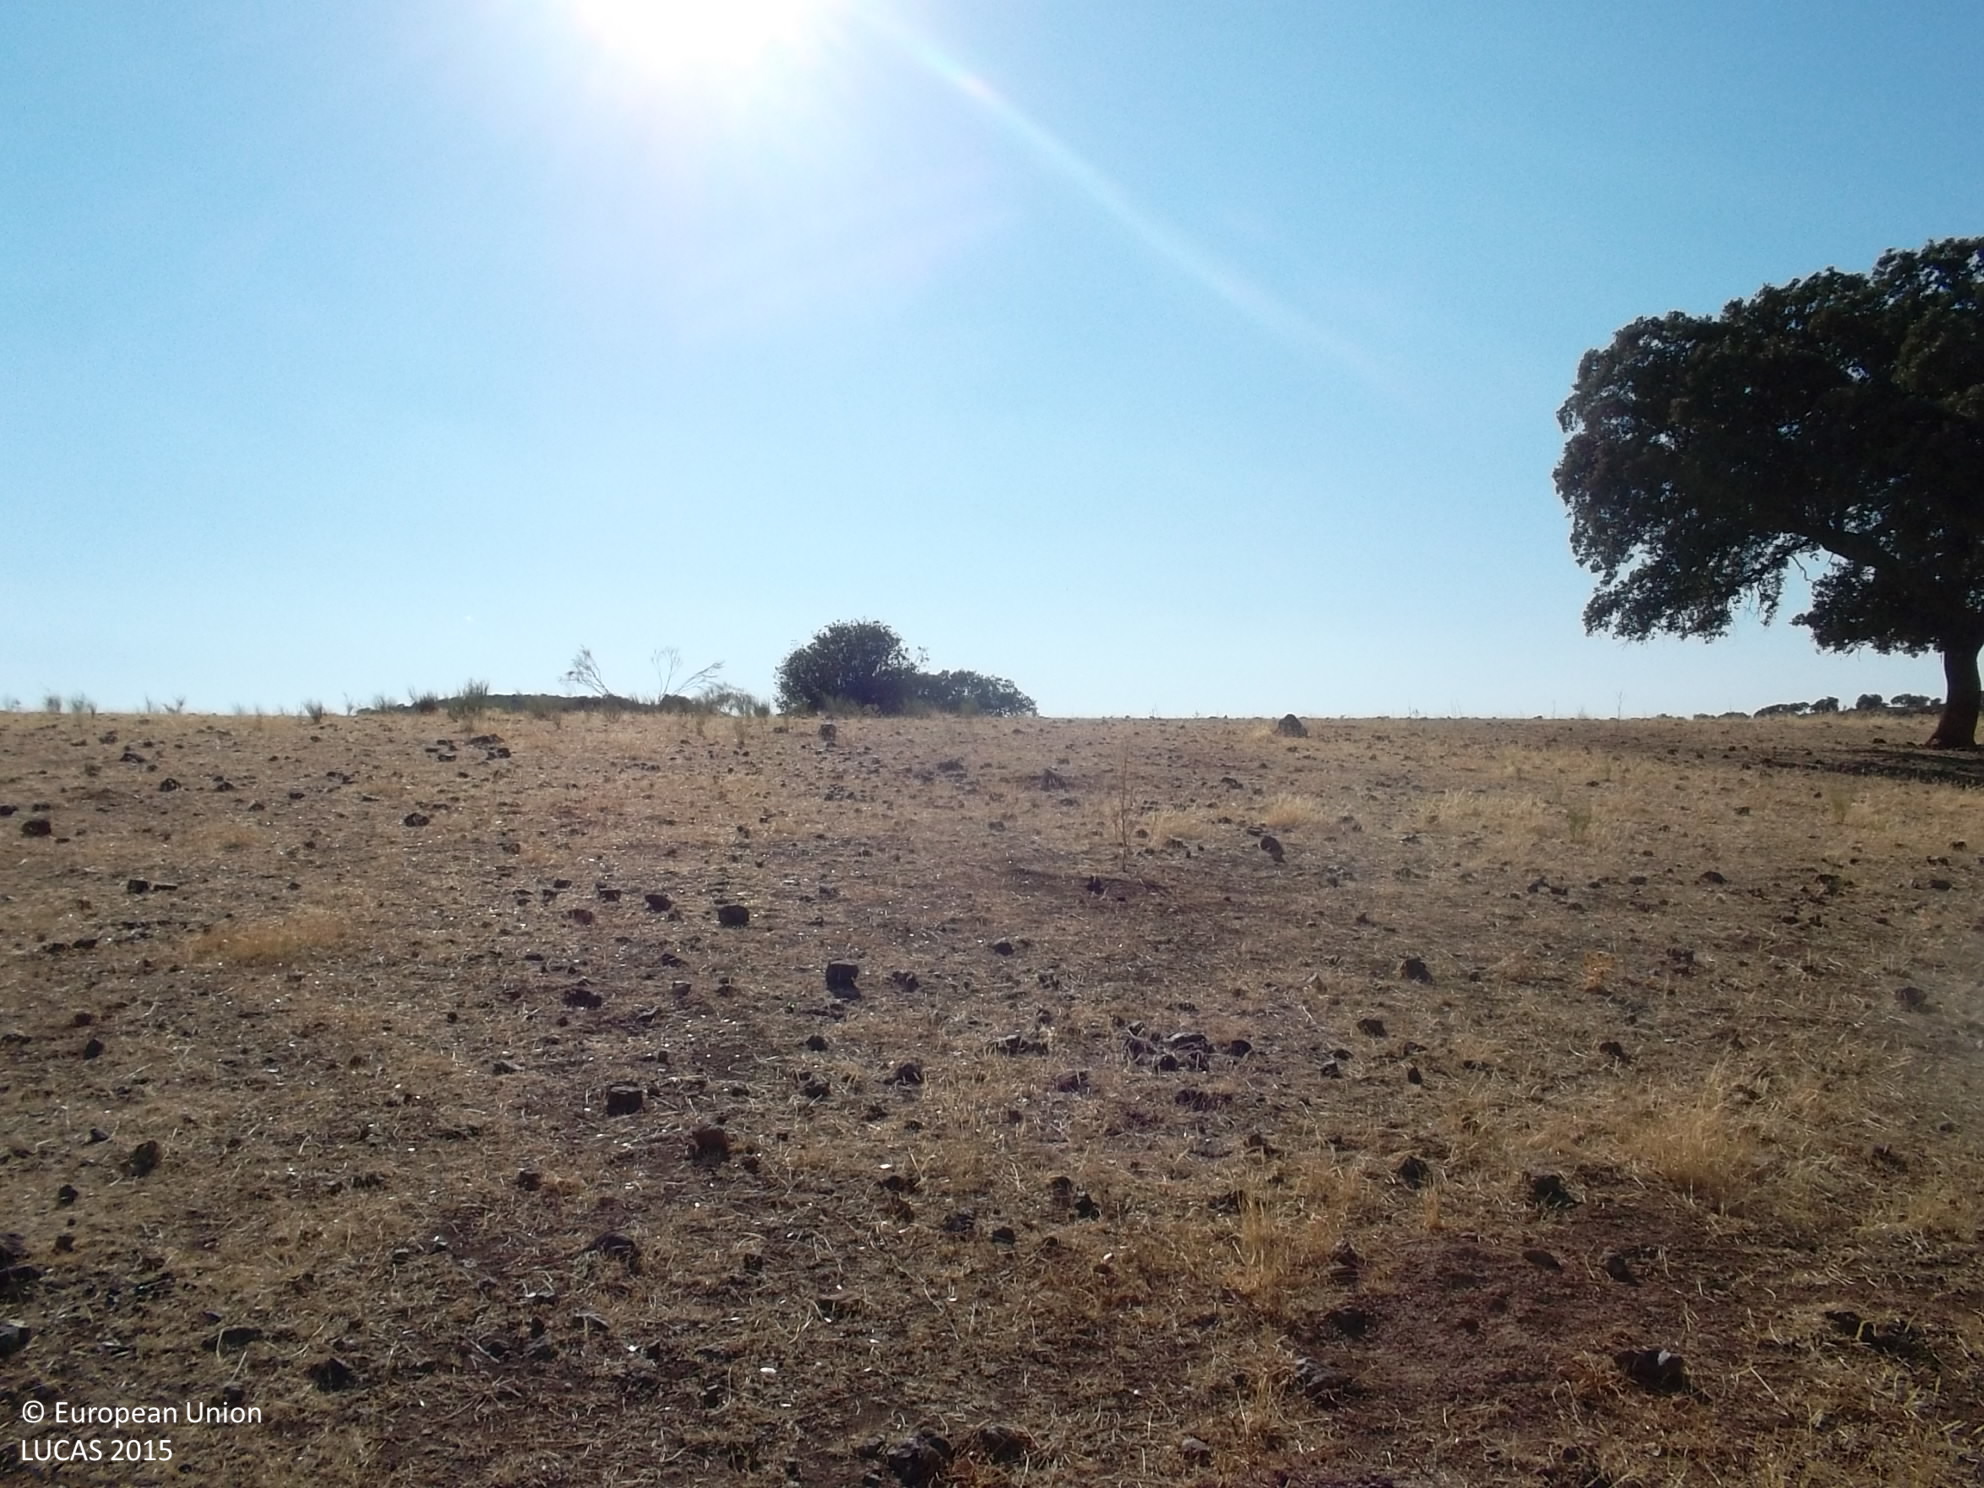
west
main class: Grassland
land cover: Grassland without tree/shrub cover
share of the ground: > 75 %
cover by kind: herbaceous plants 100 %
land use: Agriculture (excluding fallow land and kitchen gardens)
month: July
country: ES
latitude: 38.5412
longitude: -5.7700
